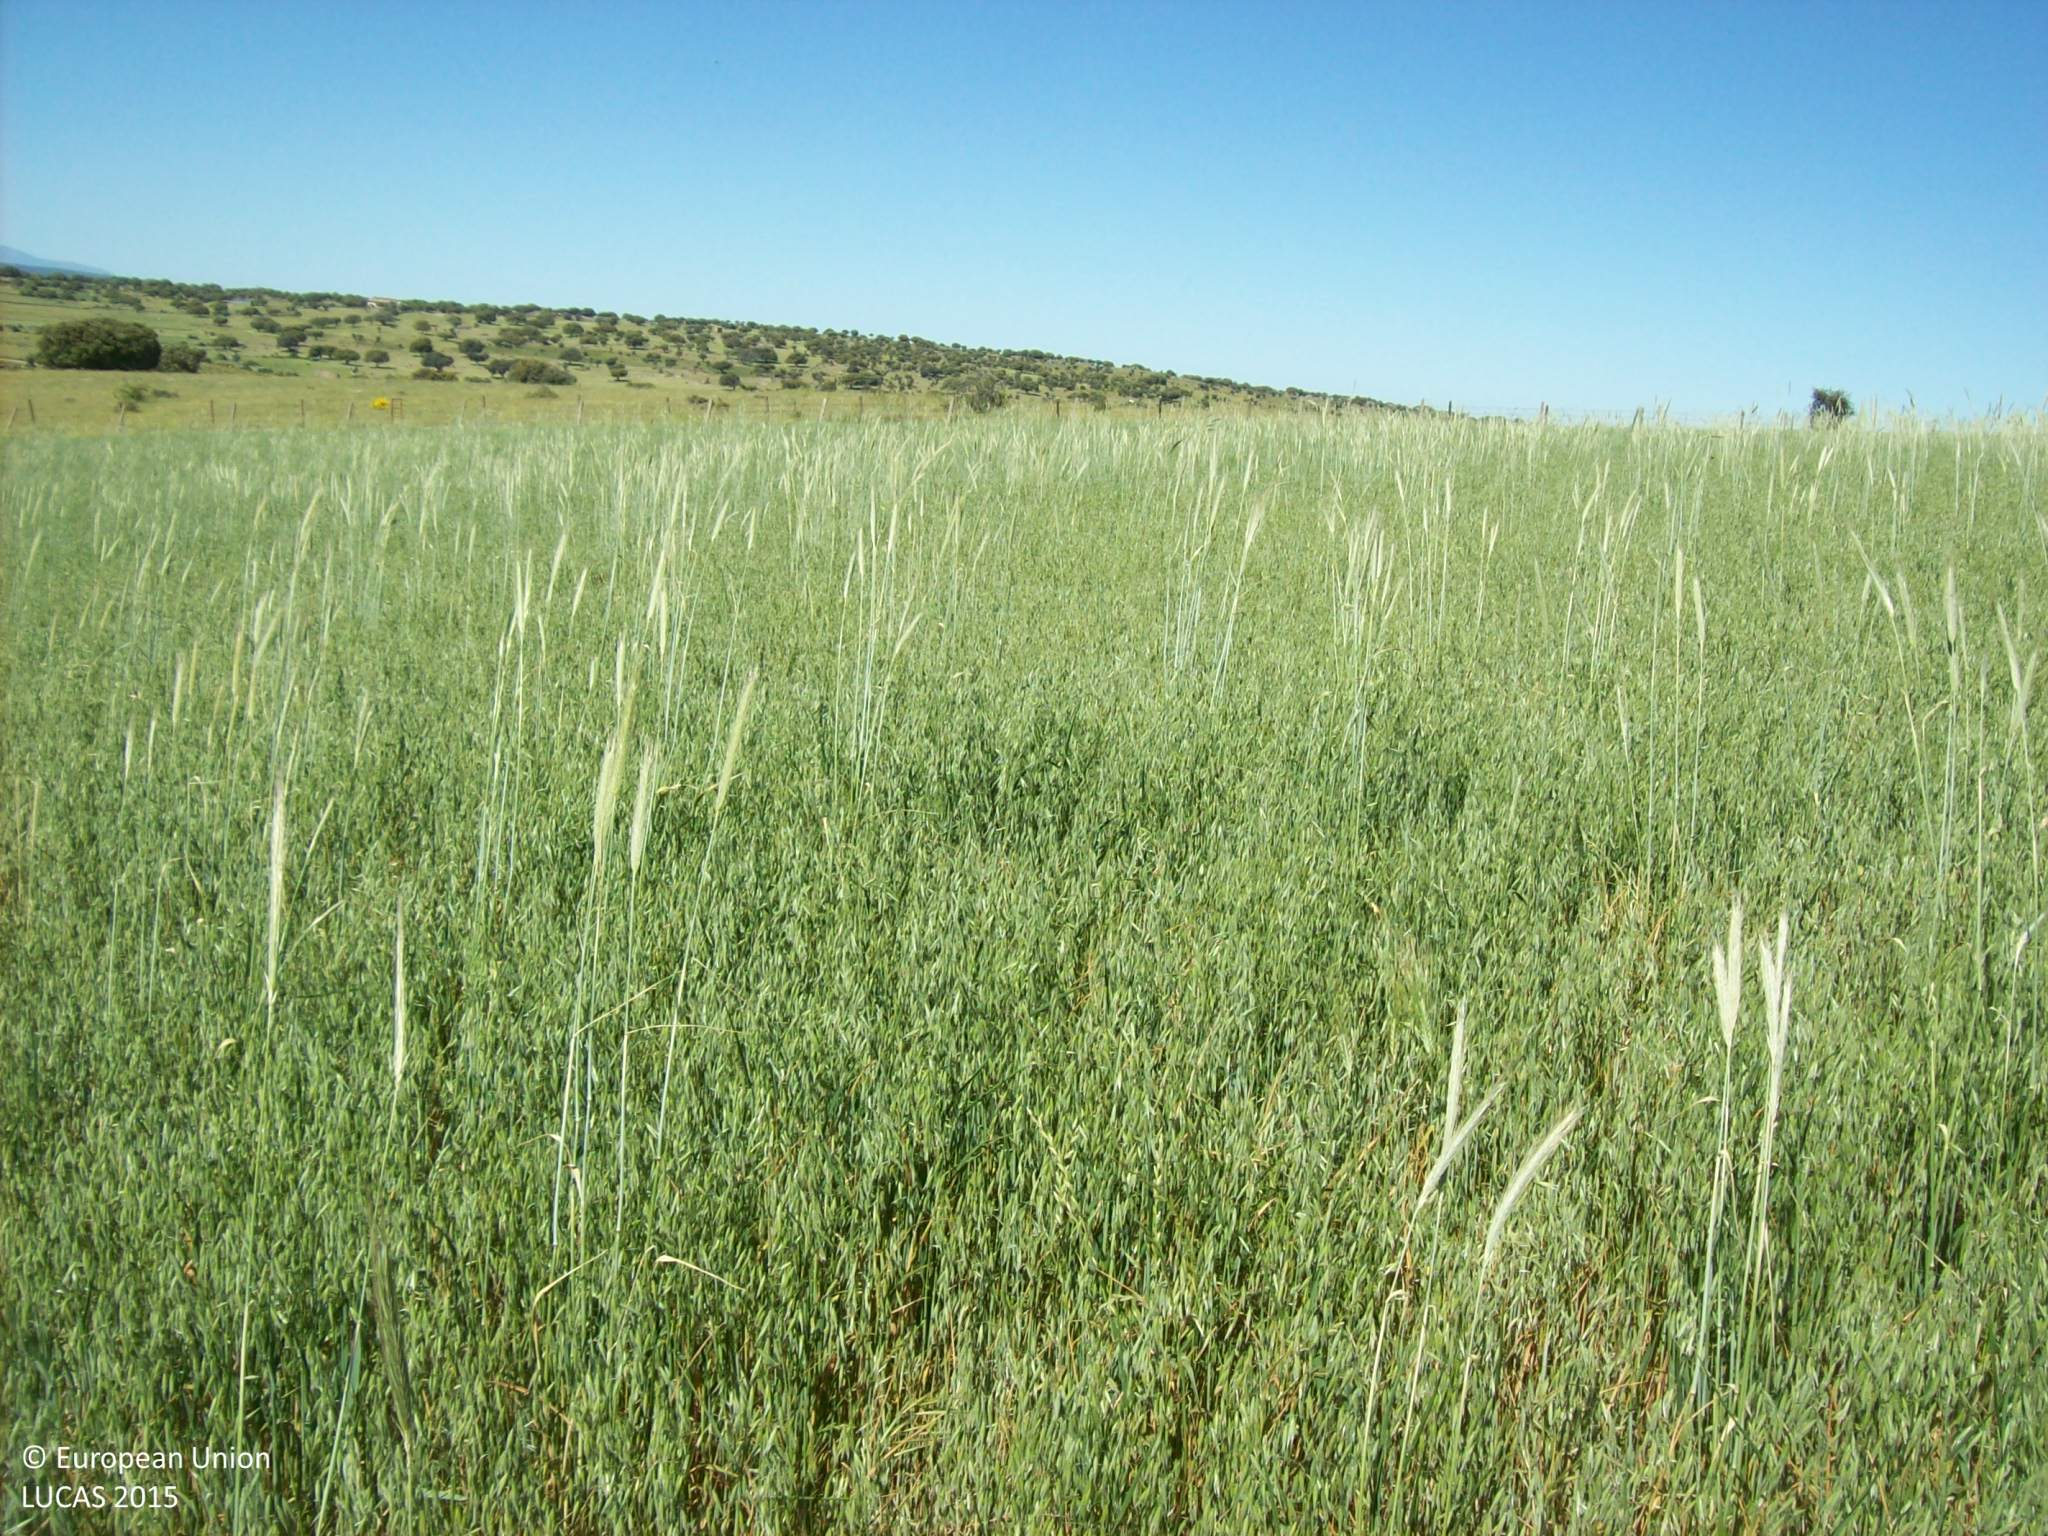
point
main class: Cropland
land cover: Mixed cereals for fodder
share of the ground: > 75 %
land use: Agriculture (excluding fallow land and kitchen gardens)
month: May
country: ES
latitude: 40.7237
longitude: -5.1111
